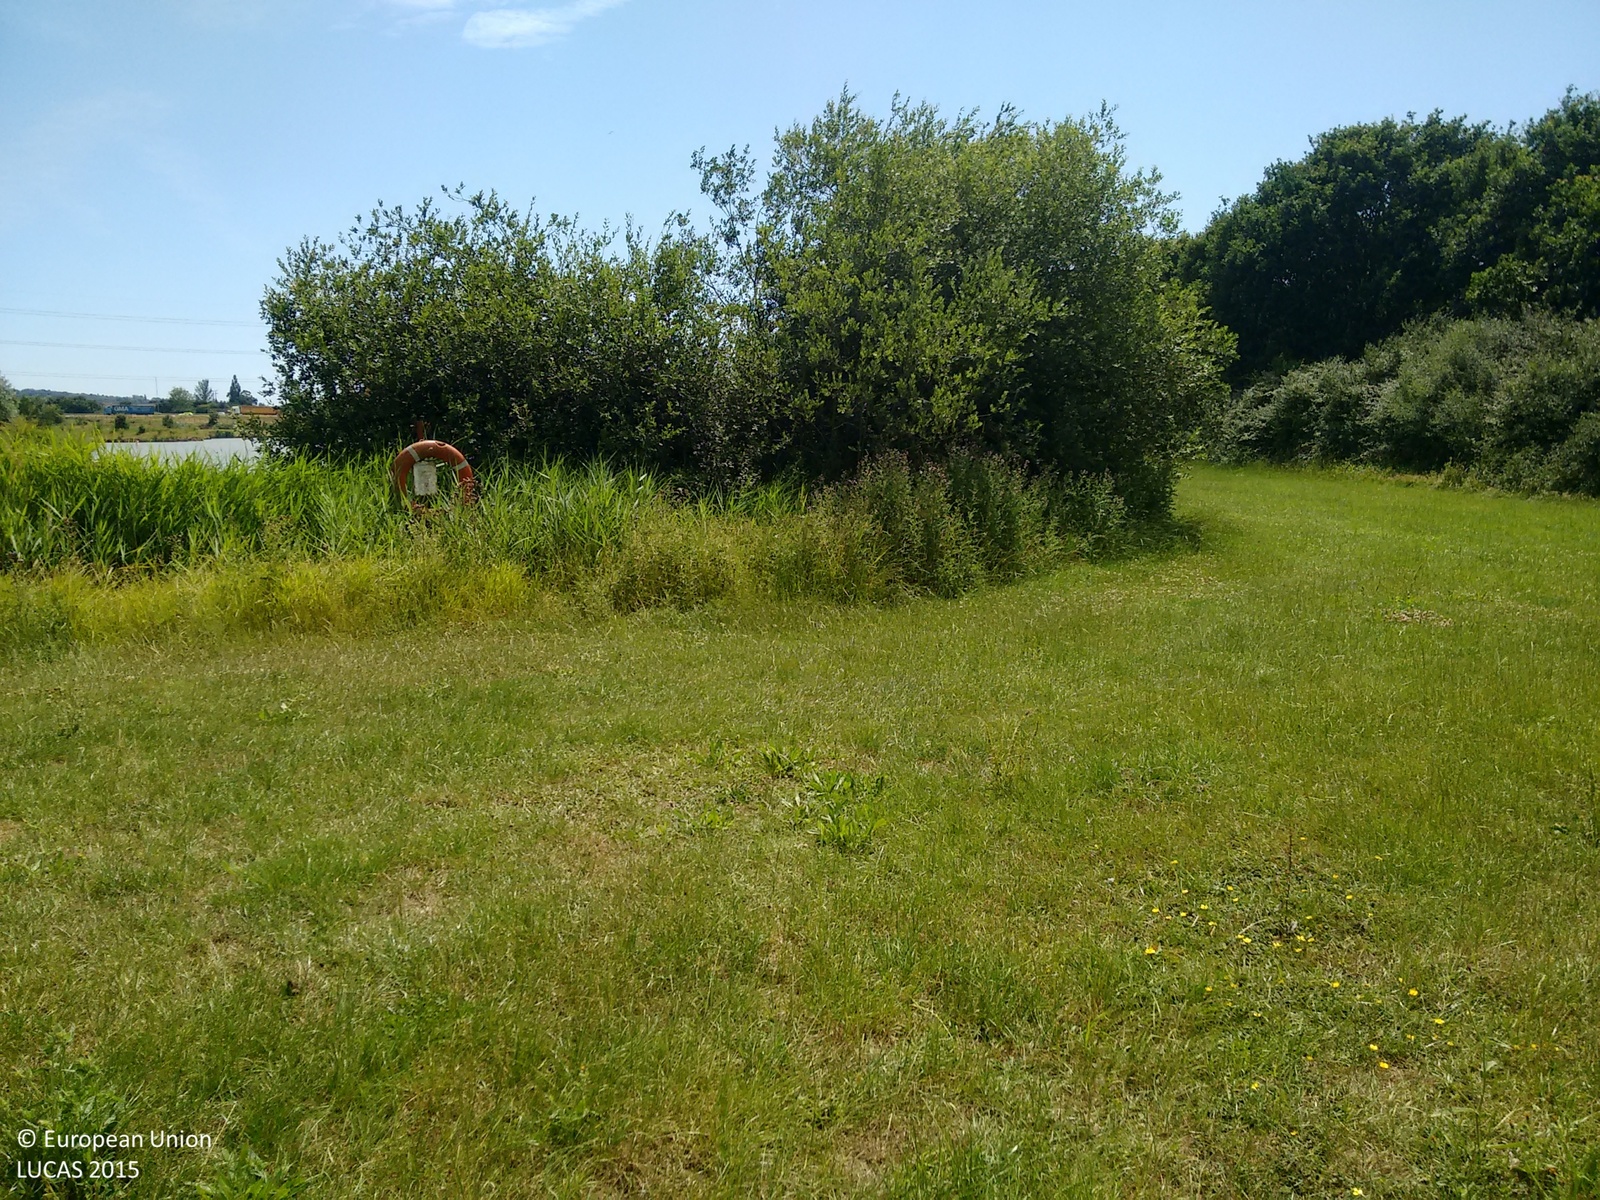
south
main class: Grassland
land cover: Grassland without tree/shrub cover
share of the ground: > 75 %
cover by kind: herbaceous plants 100 %
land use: Sport
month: July
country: GB
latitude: 51.5832
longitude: 0.5486
